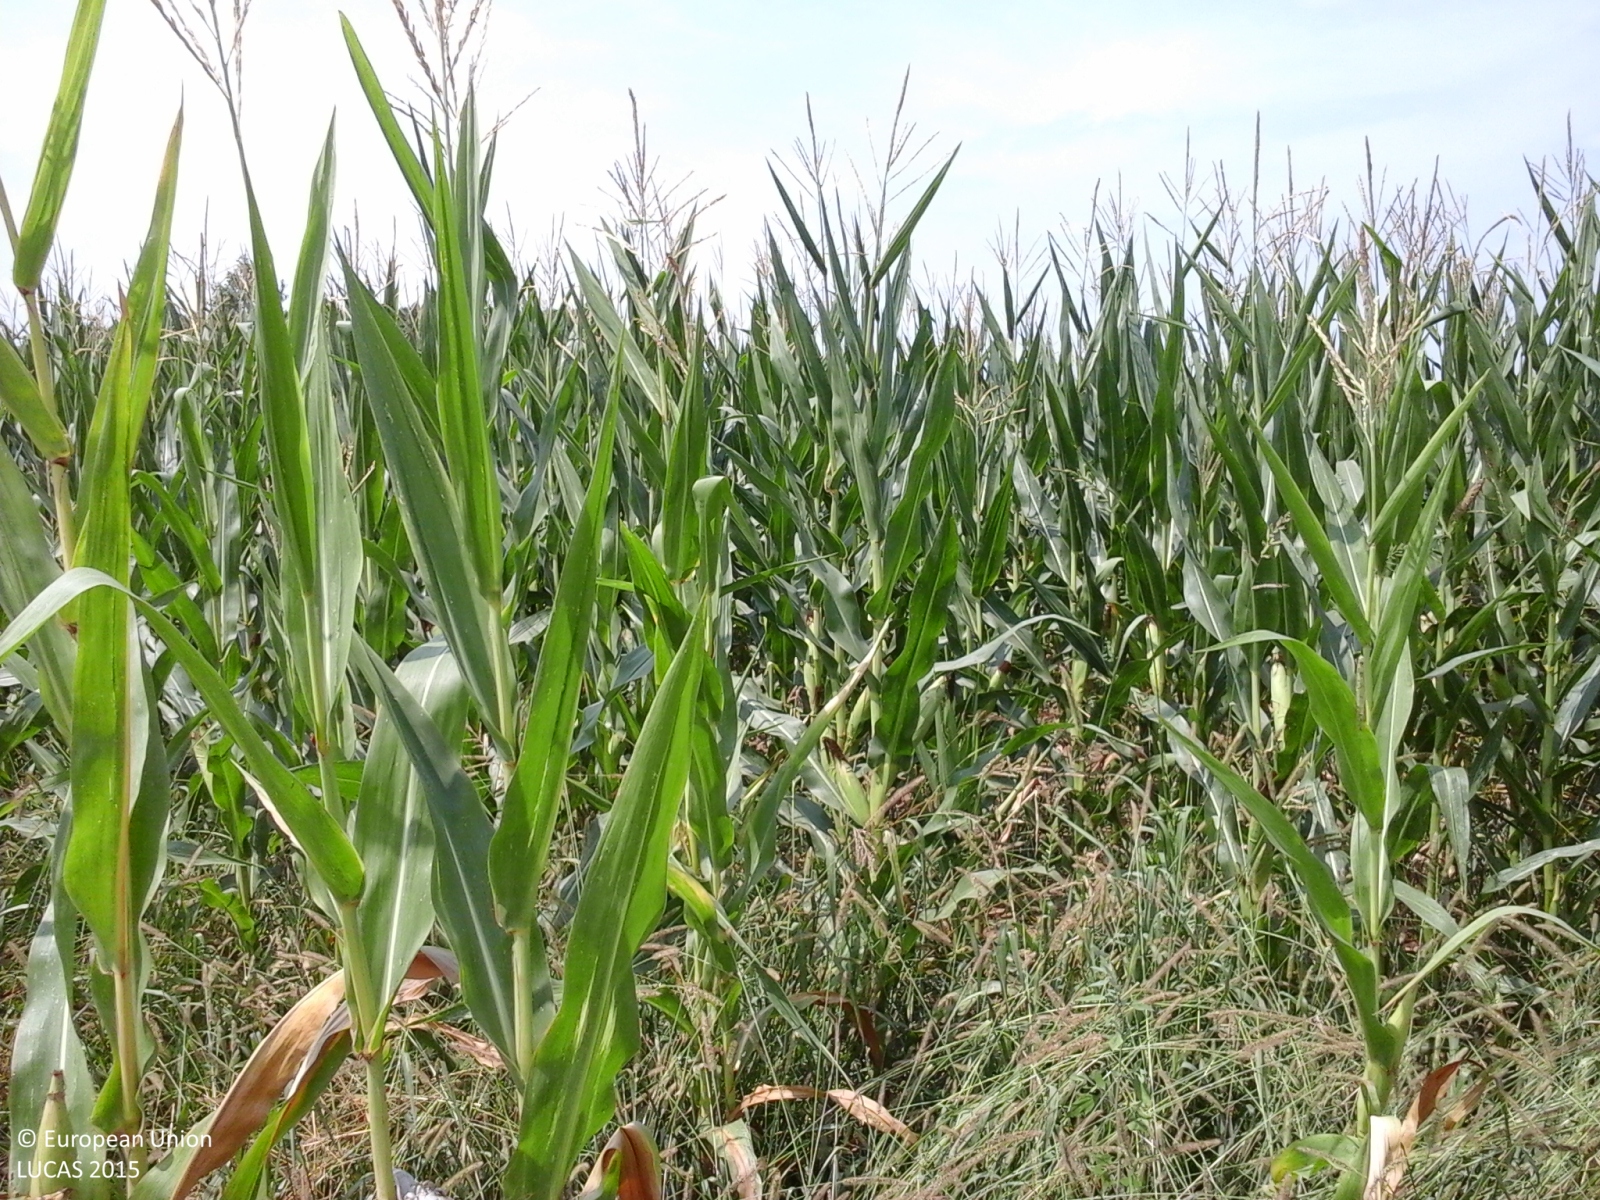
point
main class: Cropland
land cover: Maize
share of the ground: > 75 %
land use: Agriculture (excluding fallow land and kitchen gardens)
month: July
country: IT
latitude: 44.7966
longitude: 7.8173
